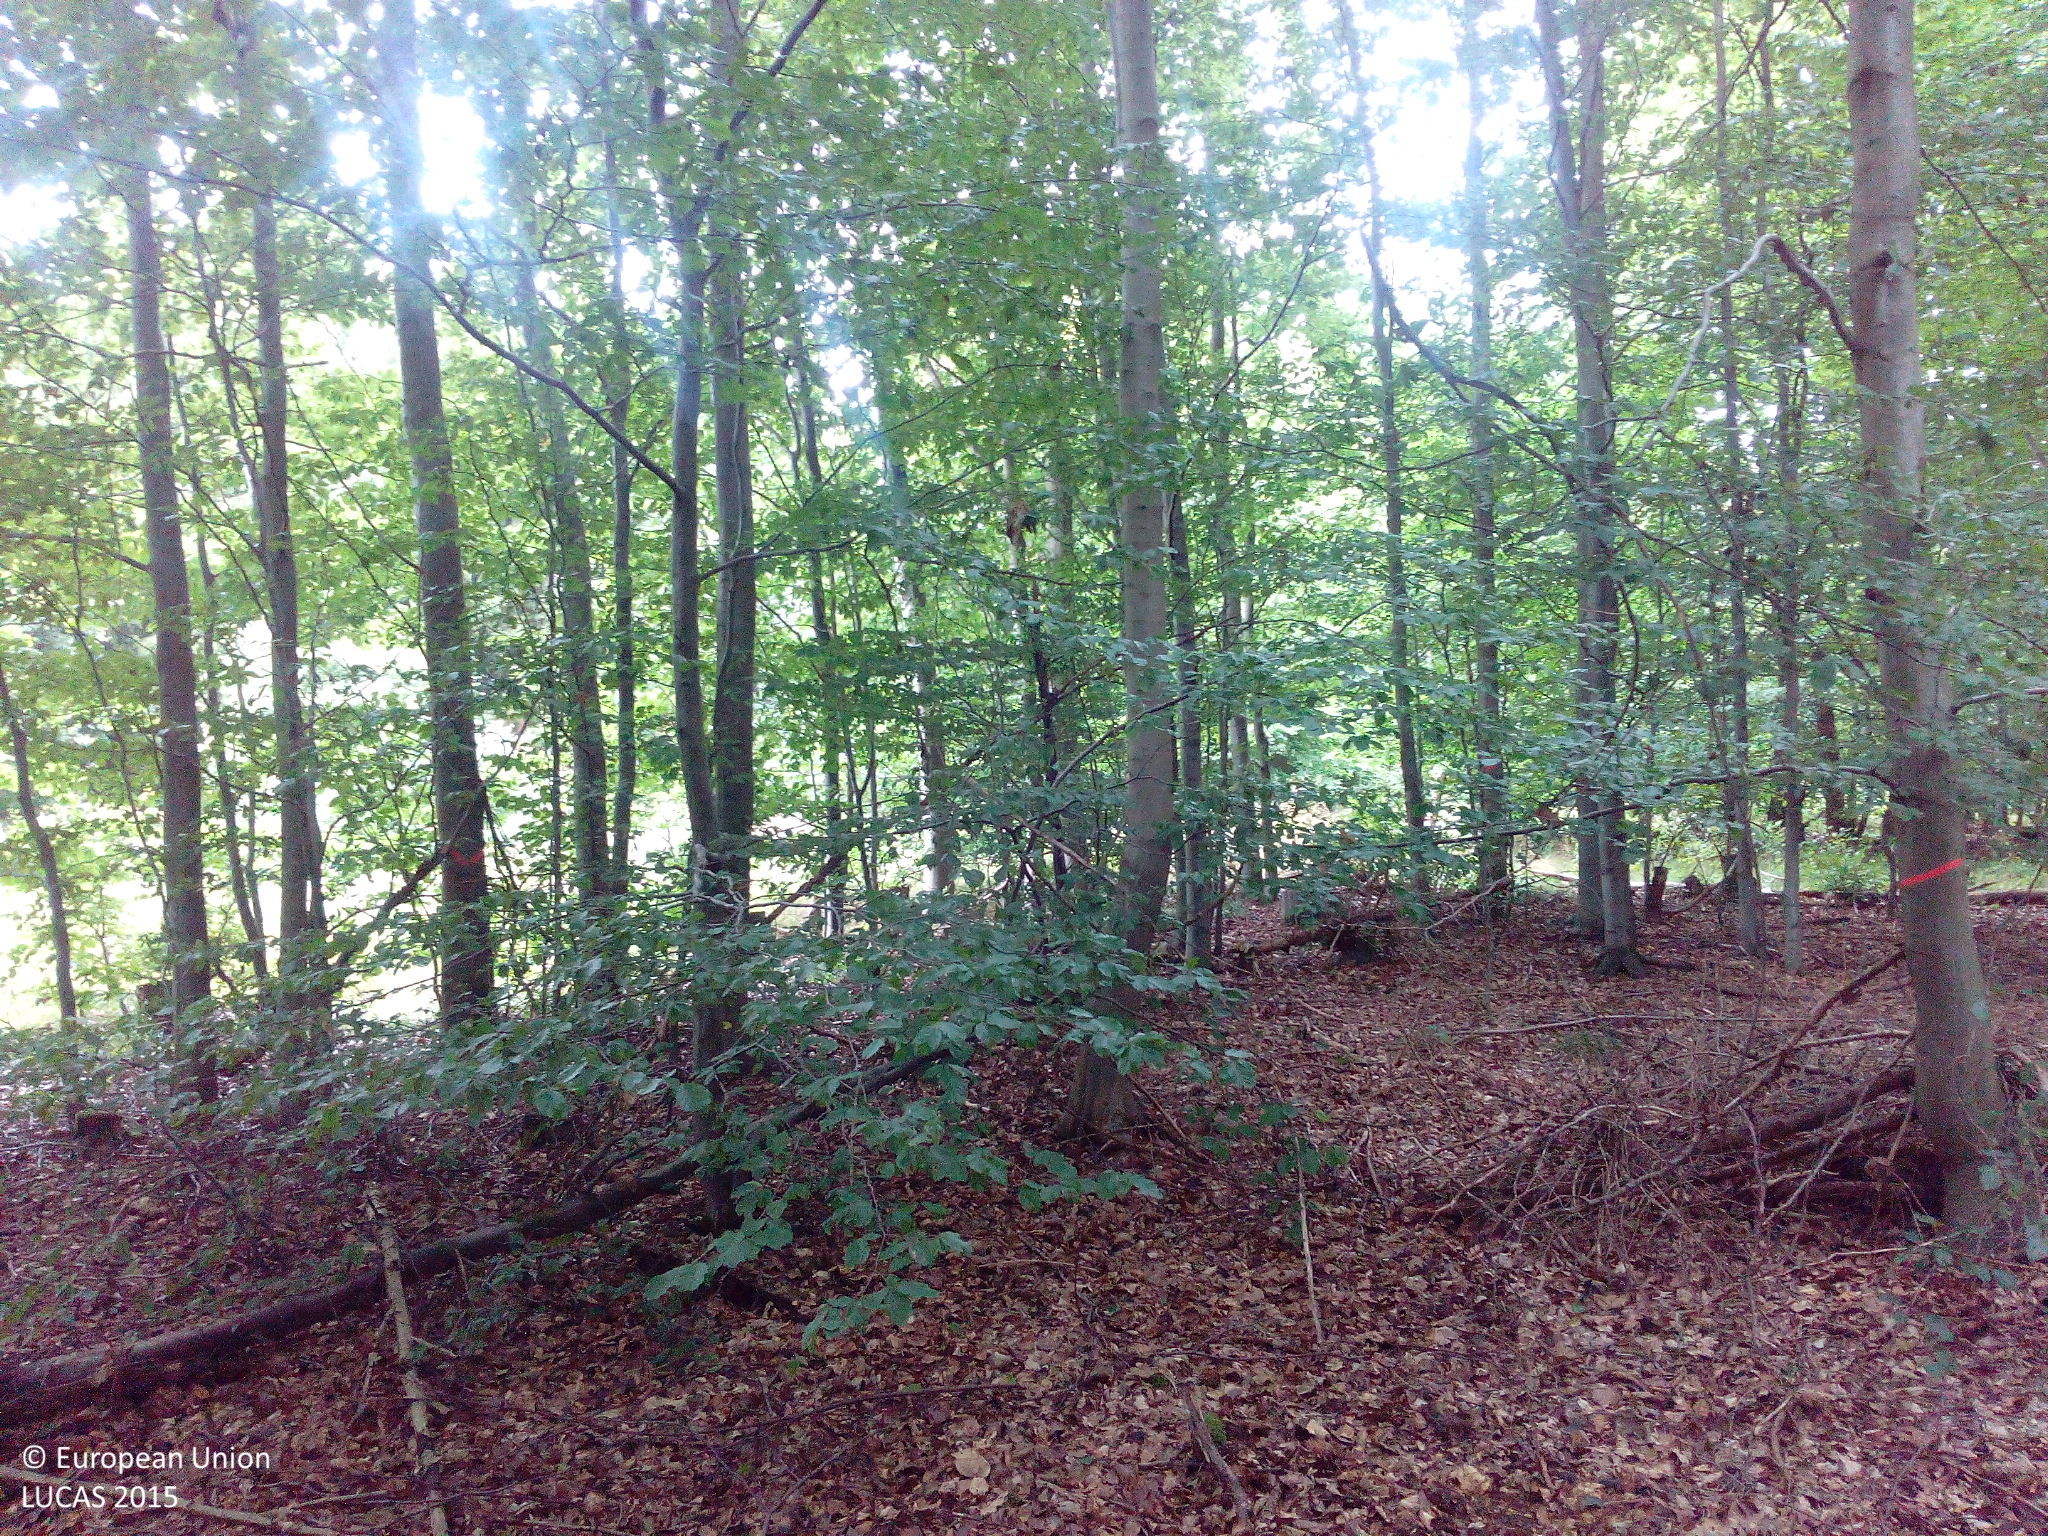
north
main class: Woodland
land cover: Other mixed woodland
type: hemiboreal forest and nemoral coniferous forest and mixed broadleaved-coniferous forest
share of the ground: > 75 %
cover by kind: coniferous forest trees 60 %, broadleaved forest trees 40 %
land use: Forestry
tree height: > 5 m
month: September
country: DE
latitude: 51.6535
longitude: 11.0838
